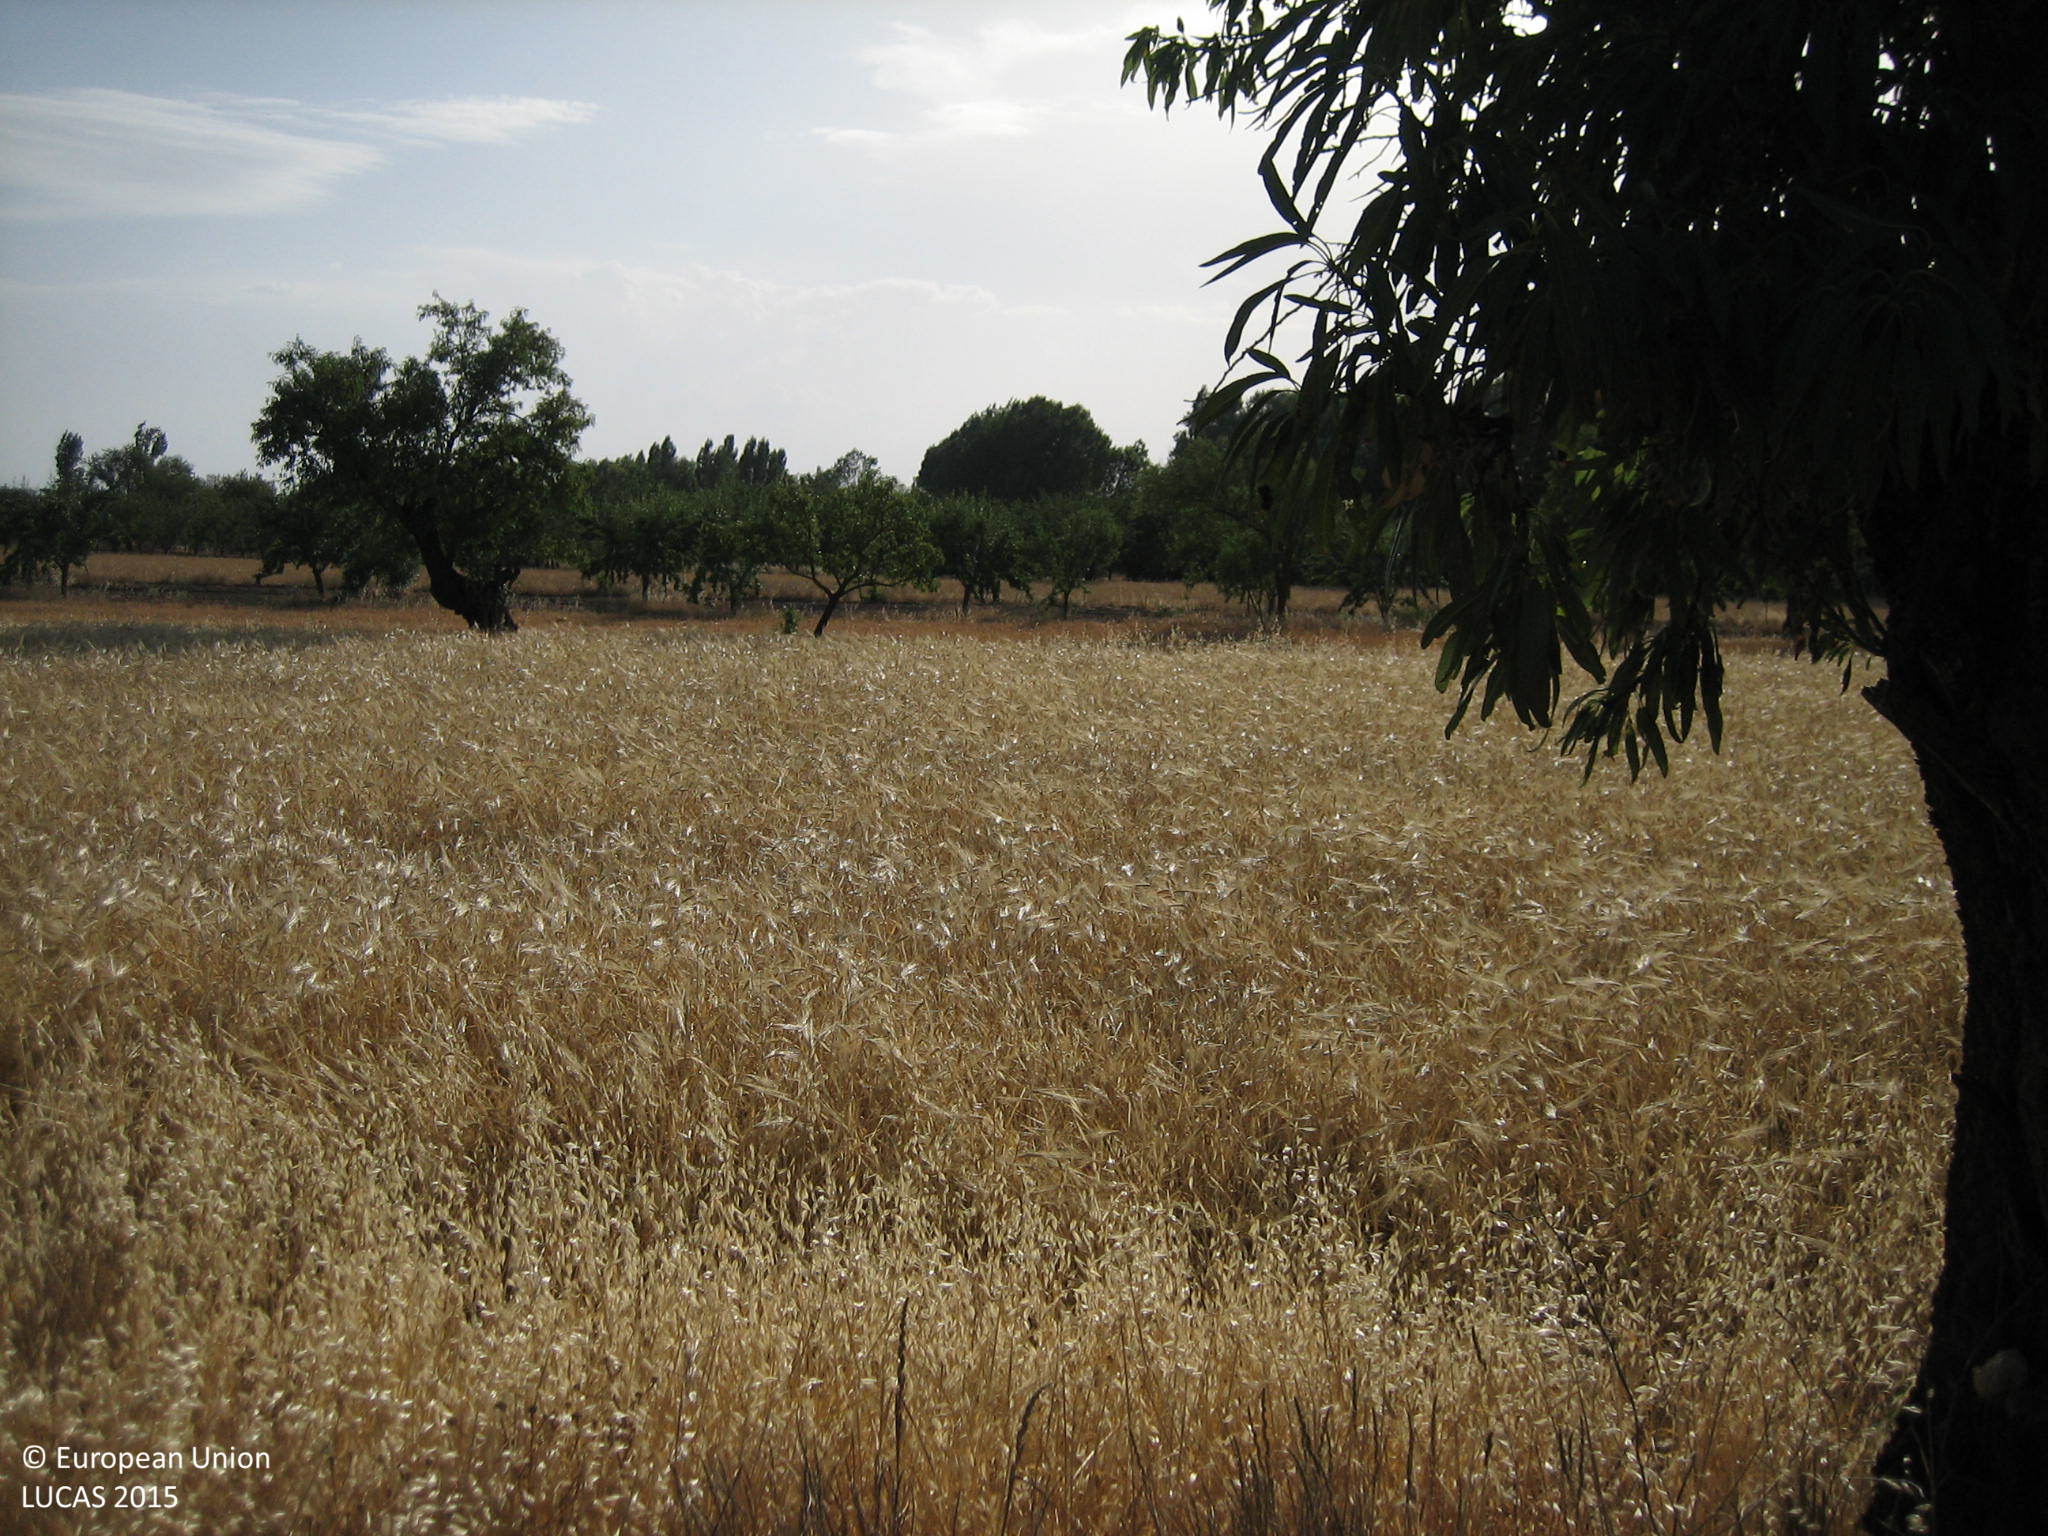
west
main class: Cropland
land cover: Olive groves
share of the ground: < 10 %
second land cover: Other bare soil
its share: > 75 %
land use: Agriculture (excluding fallow land and kitchen gardens)
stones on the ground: < 10 %
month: July
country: ES
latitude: 37.5910
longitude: -2.4097
